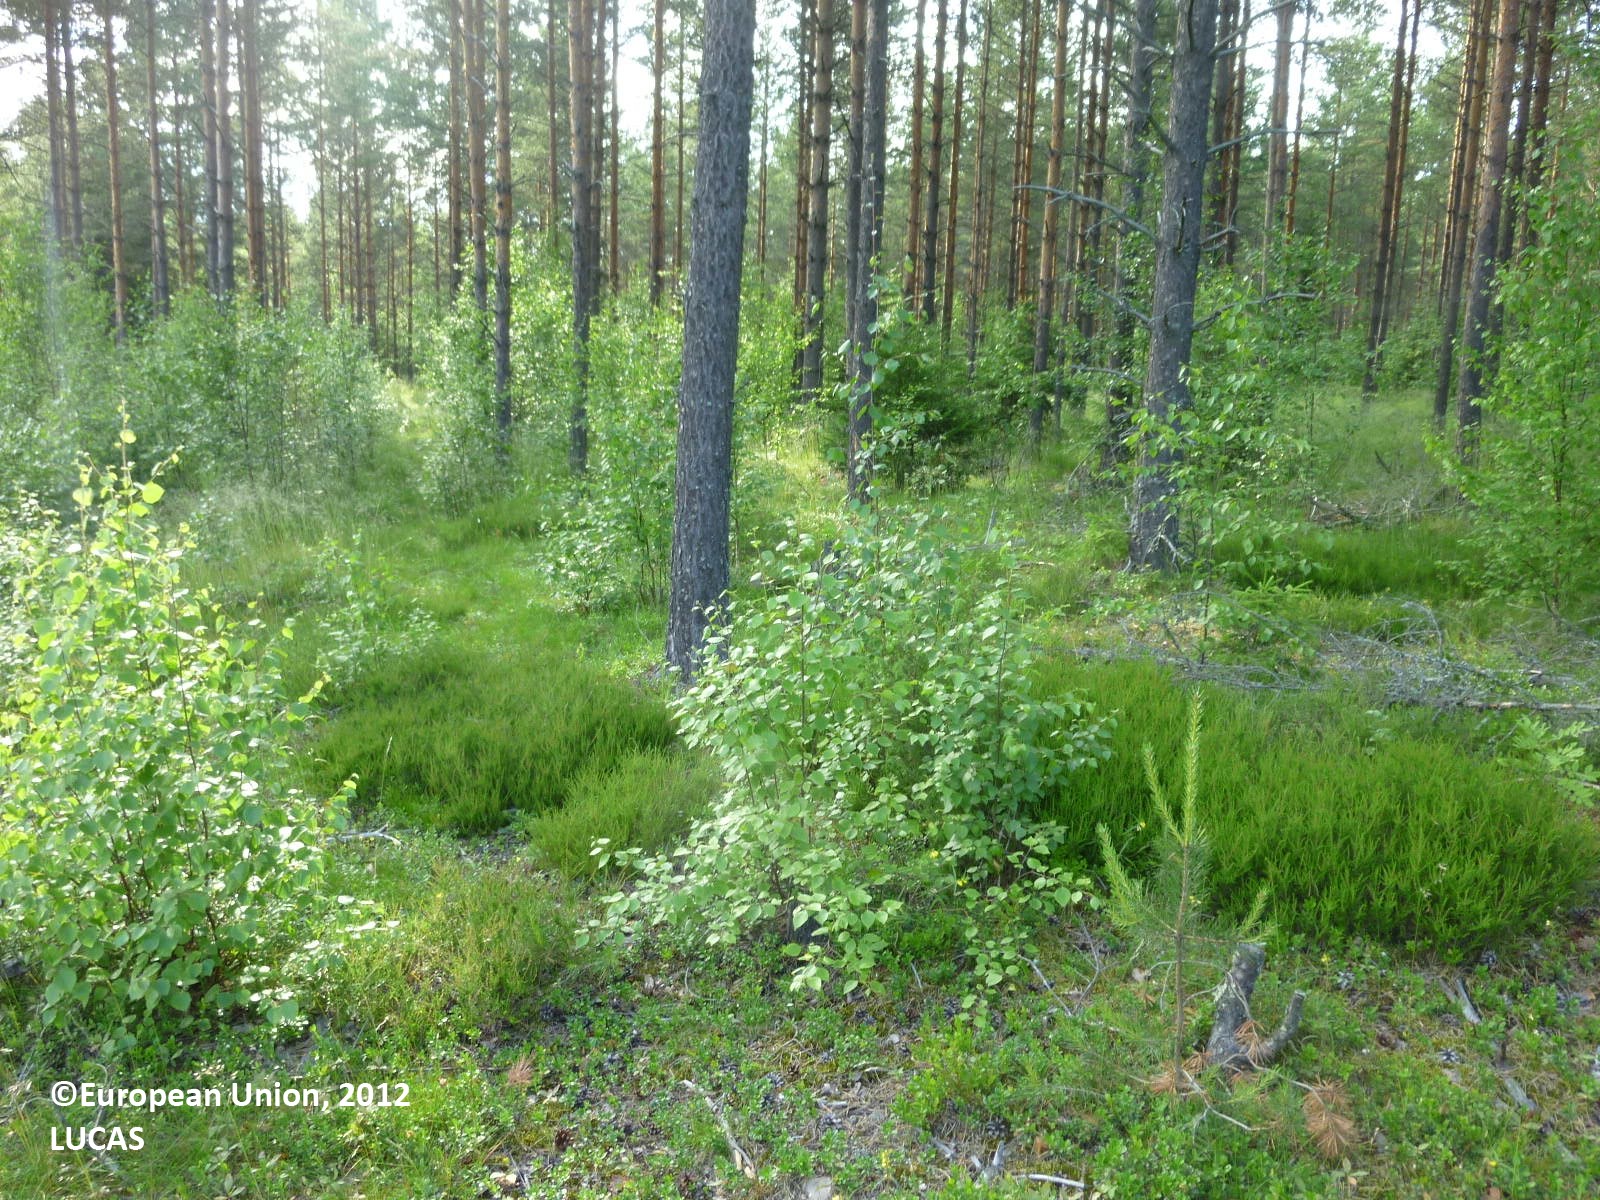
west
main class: Woodland
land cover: Pine dominated coniferous woodland
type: boreal forest
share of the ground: 50 - 75 %
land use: Forestry
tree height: > 5 m
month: July
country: FI
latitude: 61.1661
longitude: 22.3880
